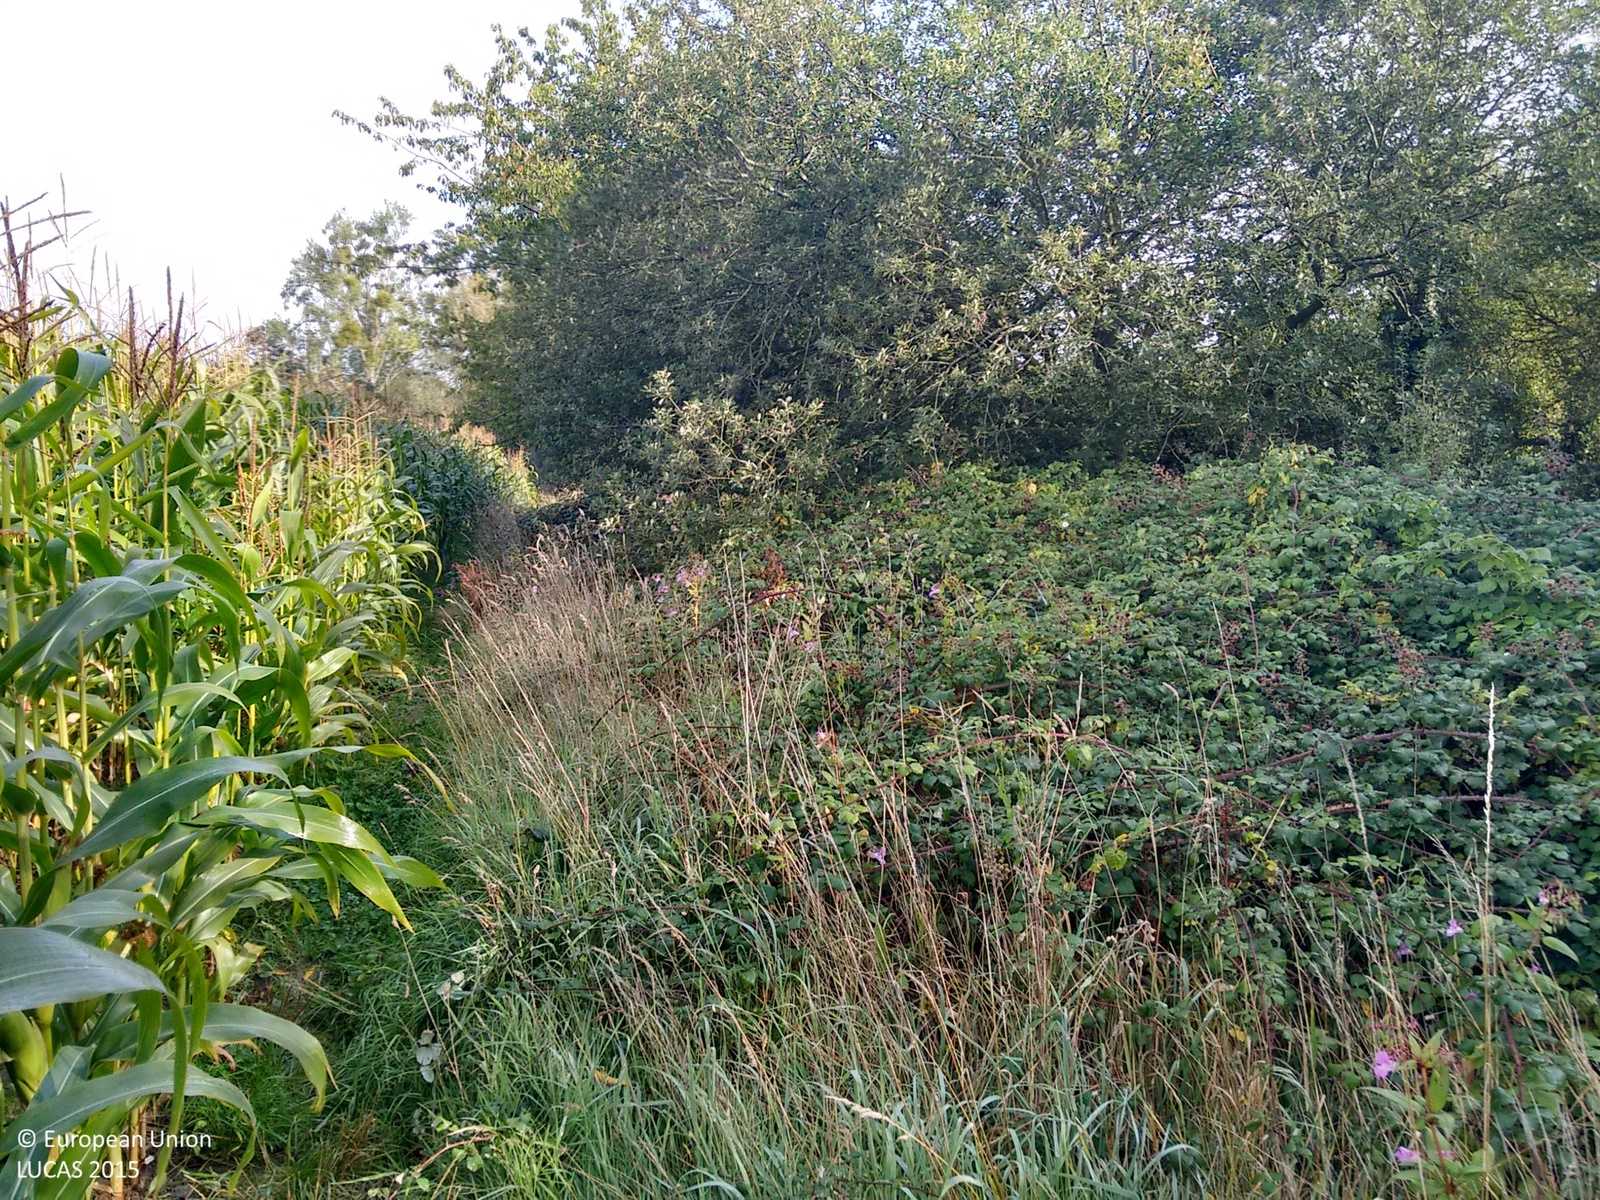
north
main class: Cropland
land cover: Arable land (only in case pi)
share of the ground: > 75 %
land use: Agriculture (excluding fallow land and kitchen gardens)
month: September
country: GB
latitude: 51.8797
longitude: -2.1323
